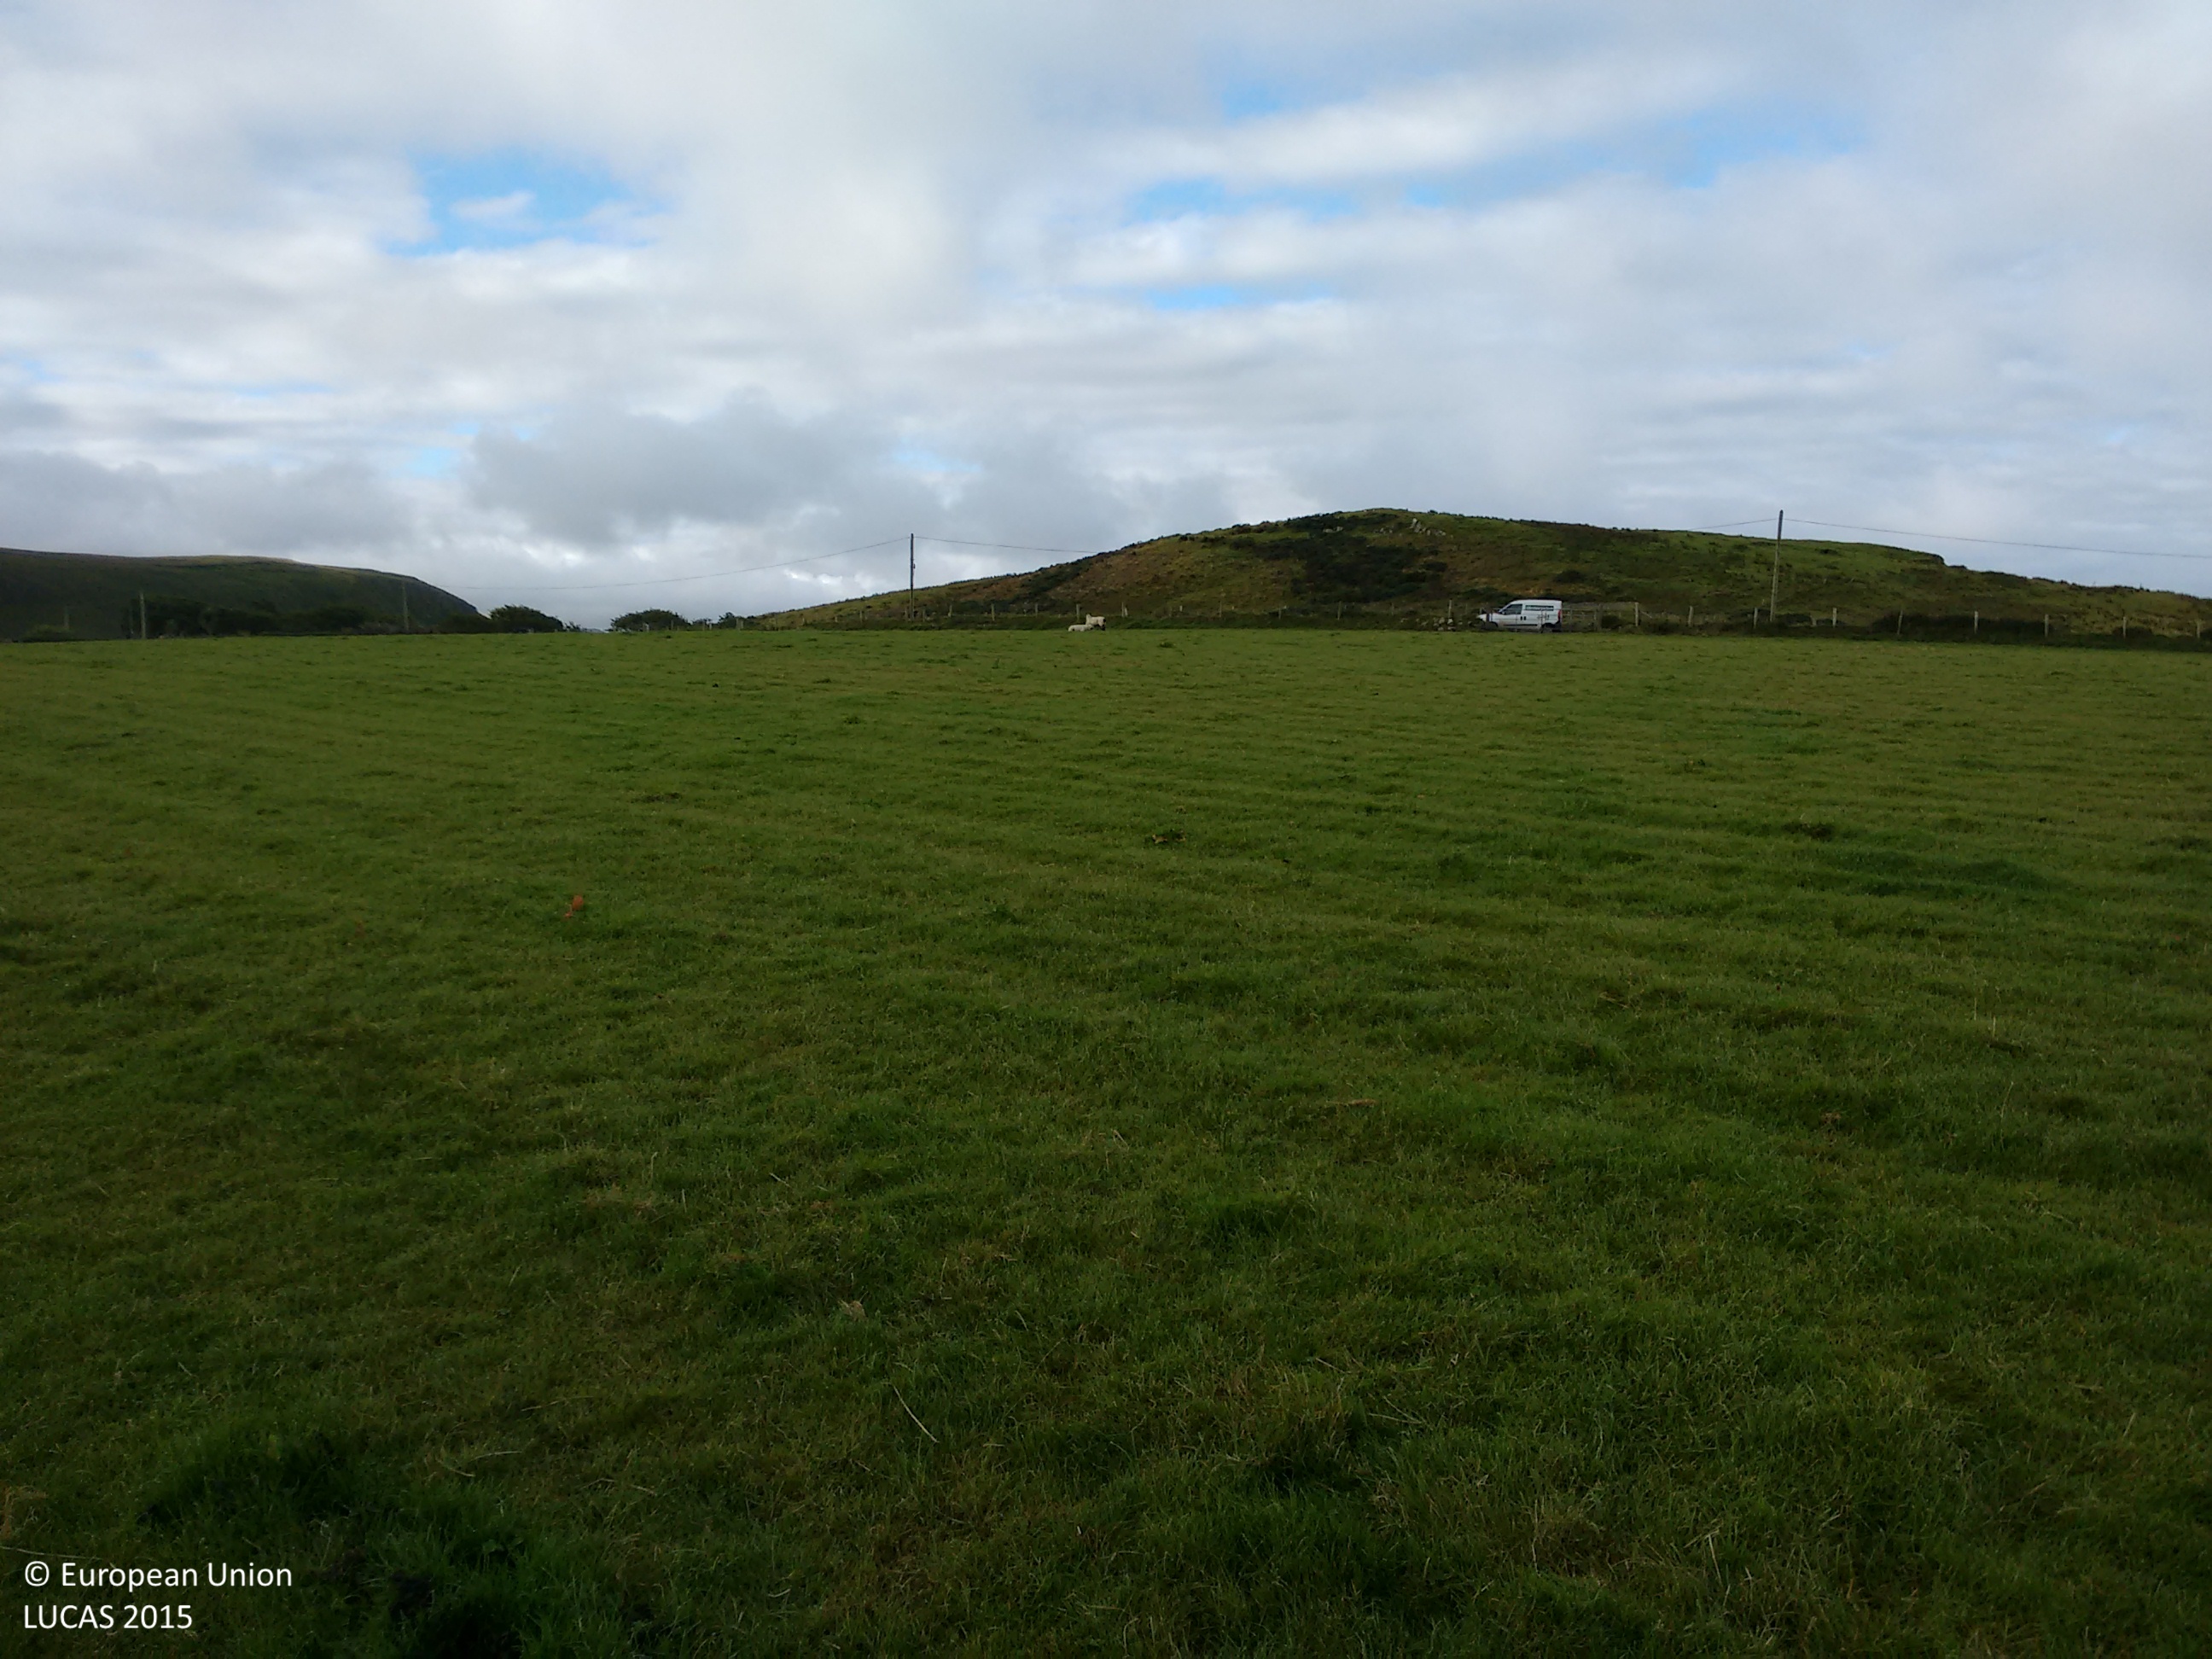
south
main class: Grassland
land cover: Grassland without tree/shrub cover
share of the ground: > 75 %
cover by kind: herbaceous plants 100 %
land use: Agriculture (excluding fallow land and kitchen gardens)
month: September
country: IE
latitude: 55.3290
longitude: -7.3118
